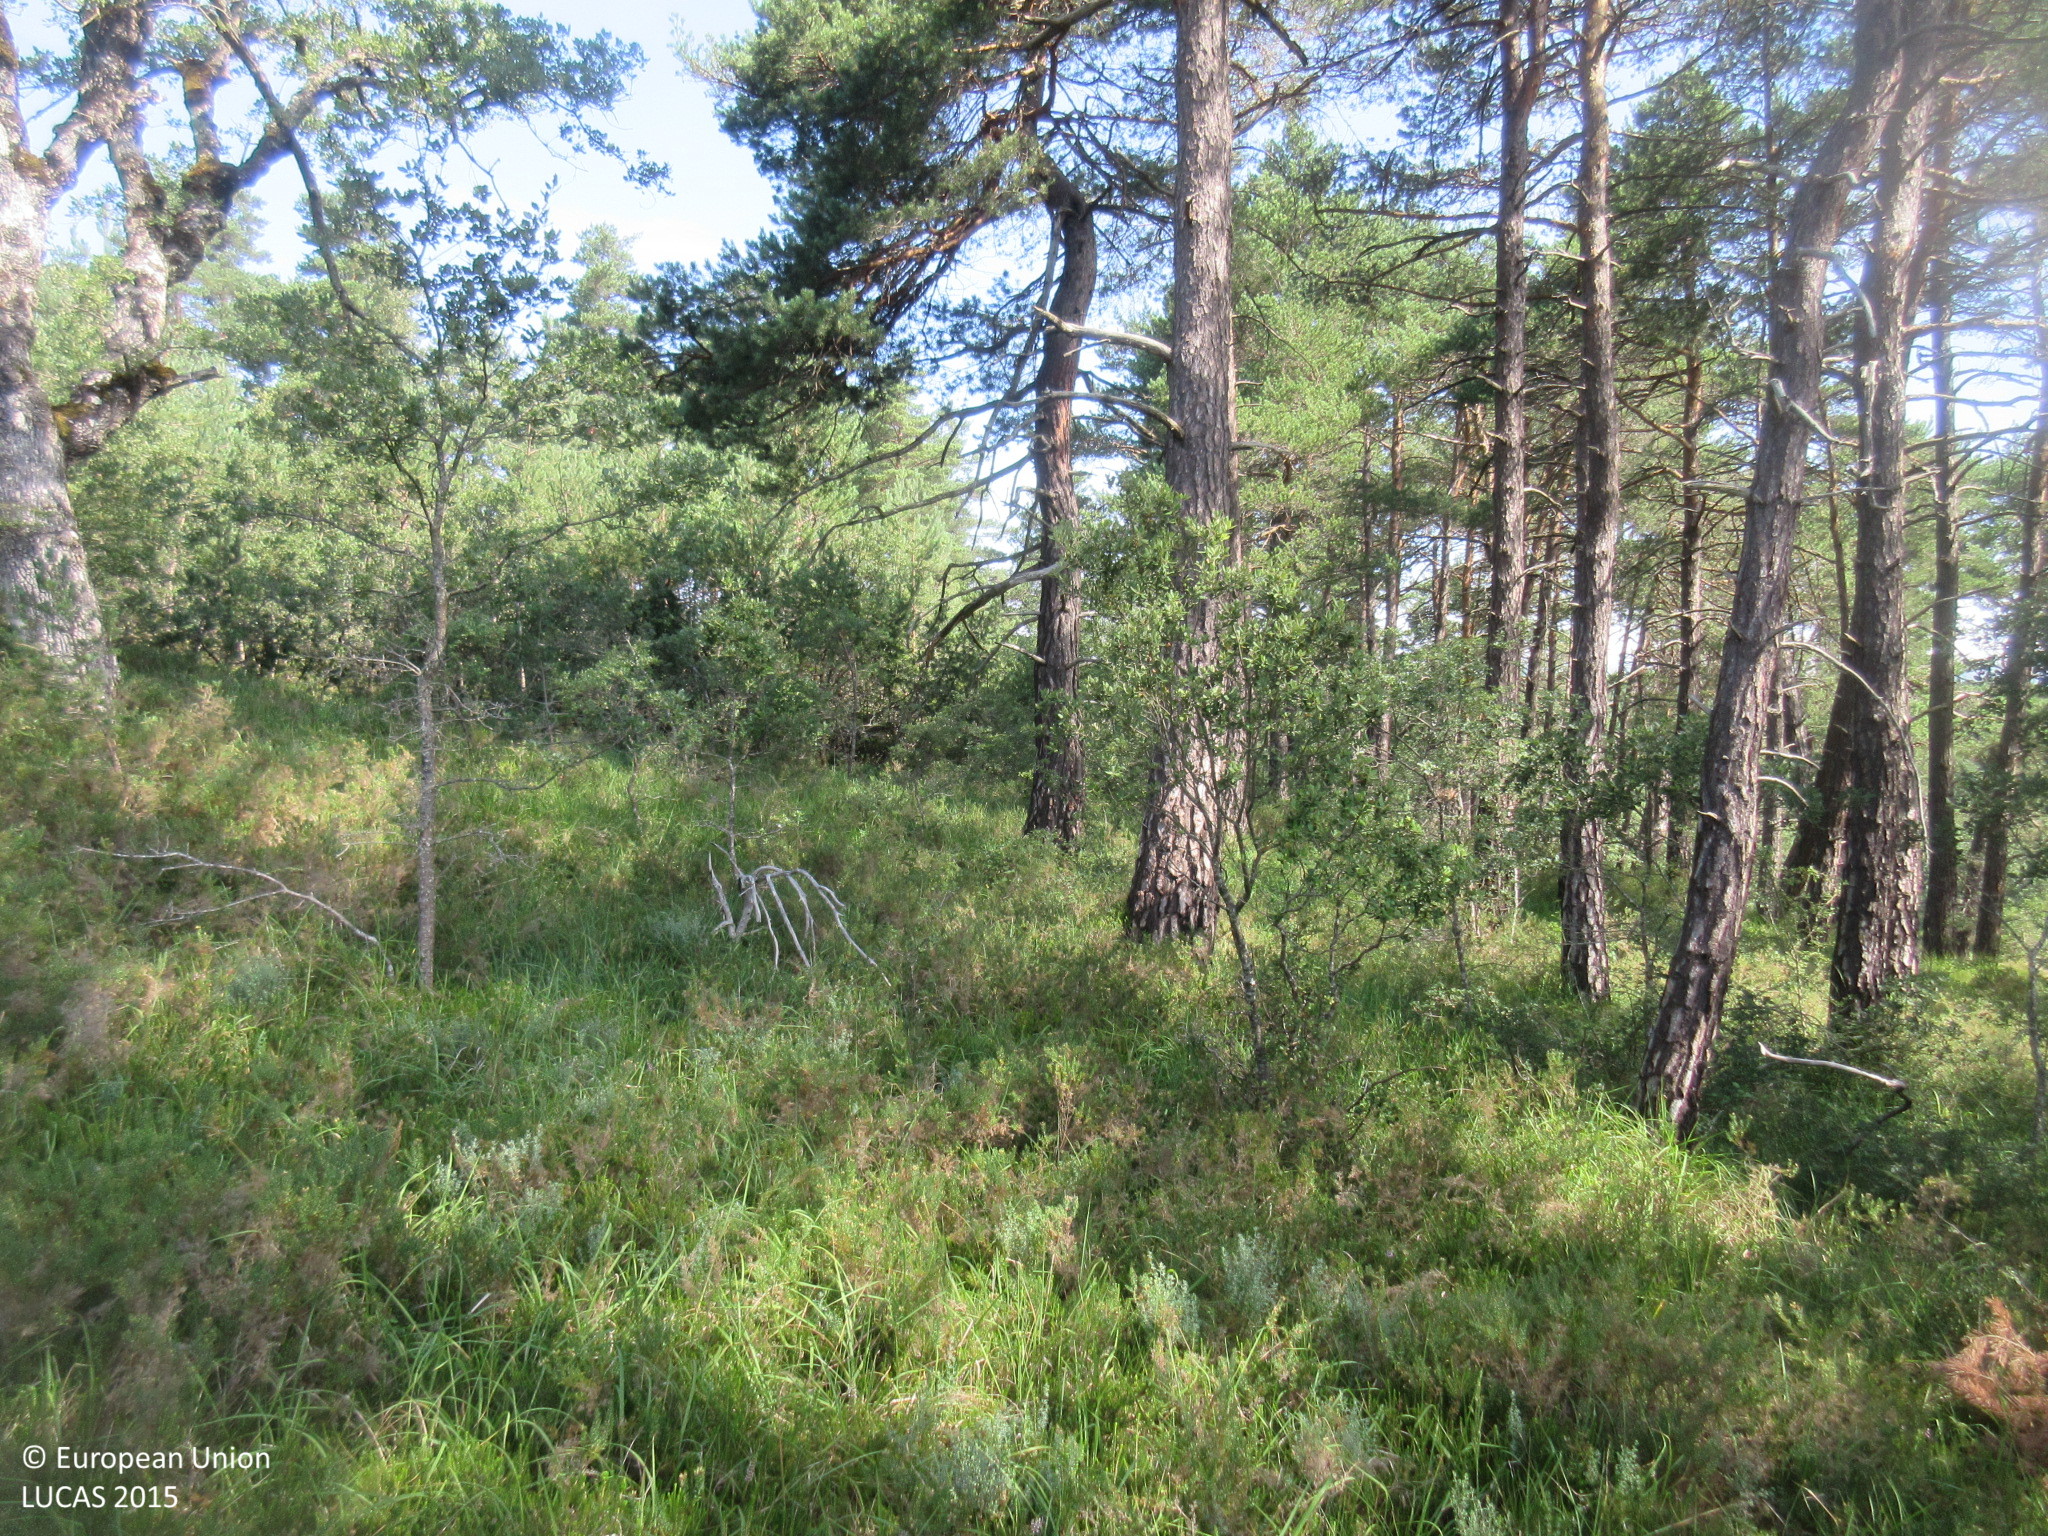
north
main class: Woodland
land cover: Broadleaved woodland
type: broadleaved evergreen forest
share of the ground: > 75 %
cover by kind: broadleaved forest trees 80 %, shrubs 20 %
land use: Forestry
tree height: > 5 m
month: July
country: ES
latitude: 42.9910
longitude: -3.3449
